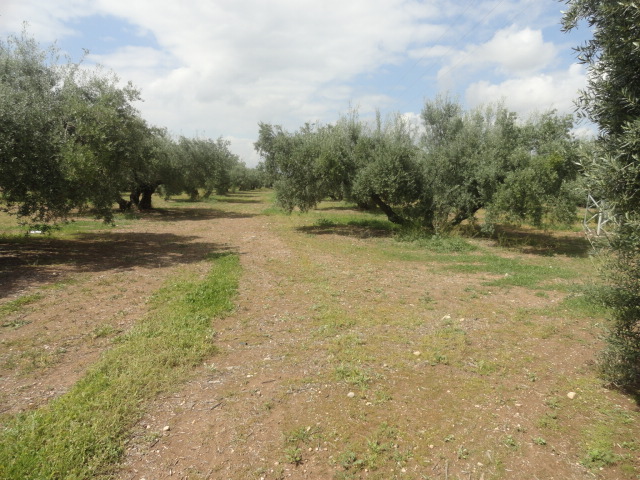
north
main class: Cropland
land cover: Olive groves
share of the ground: 50 - 75 %
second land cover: Spontaneously vegetated surfaces
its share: 25 - 50 %
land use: Agriculture (excluding fallow land and kitchen gardens)
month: April
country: ES
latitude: 37.6162
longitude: -4.5421
